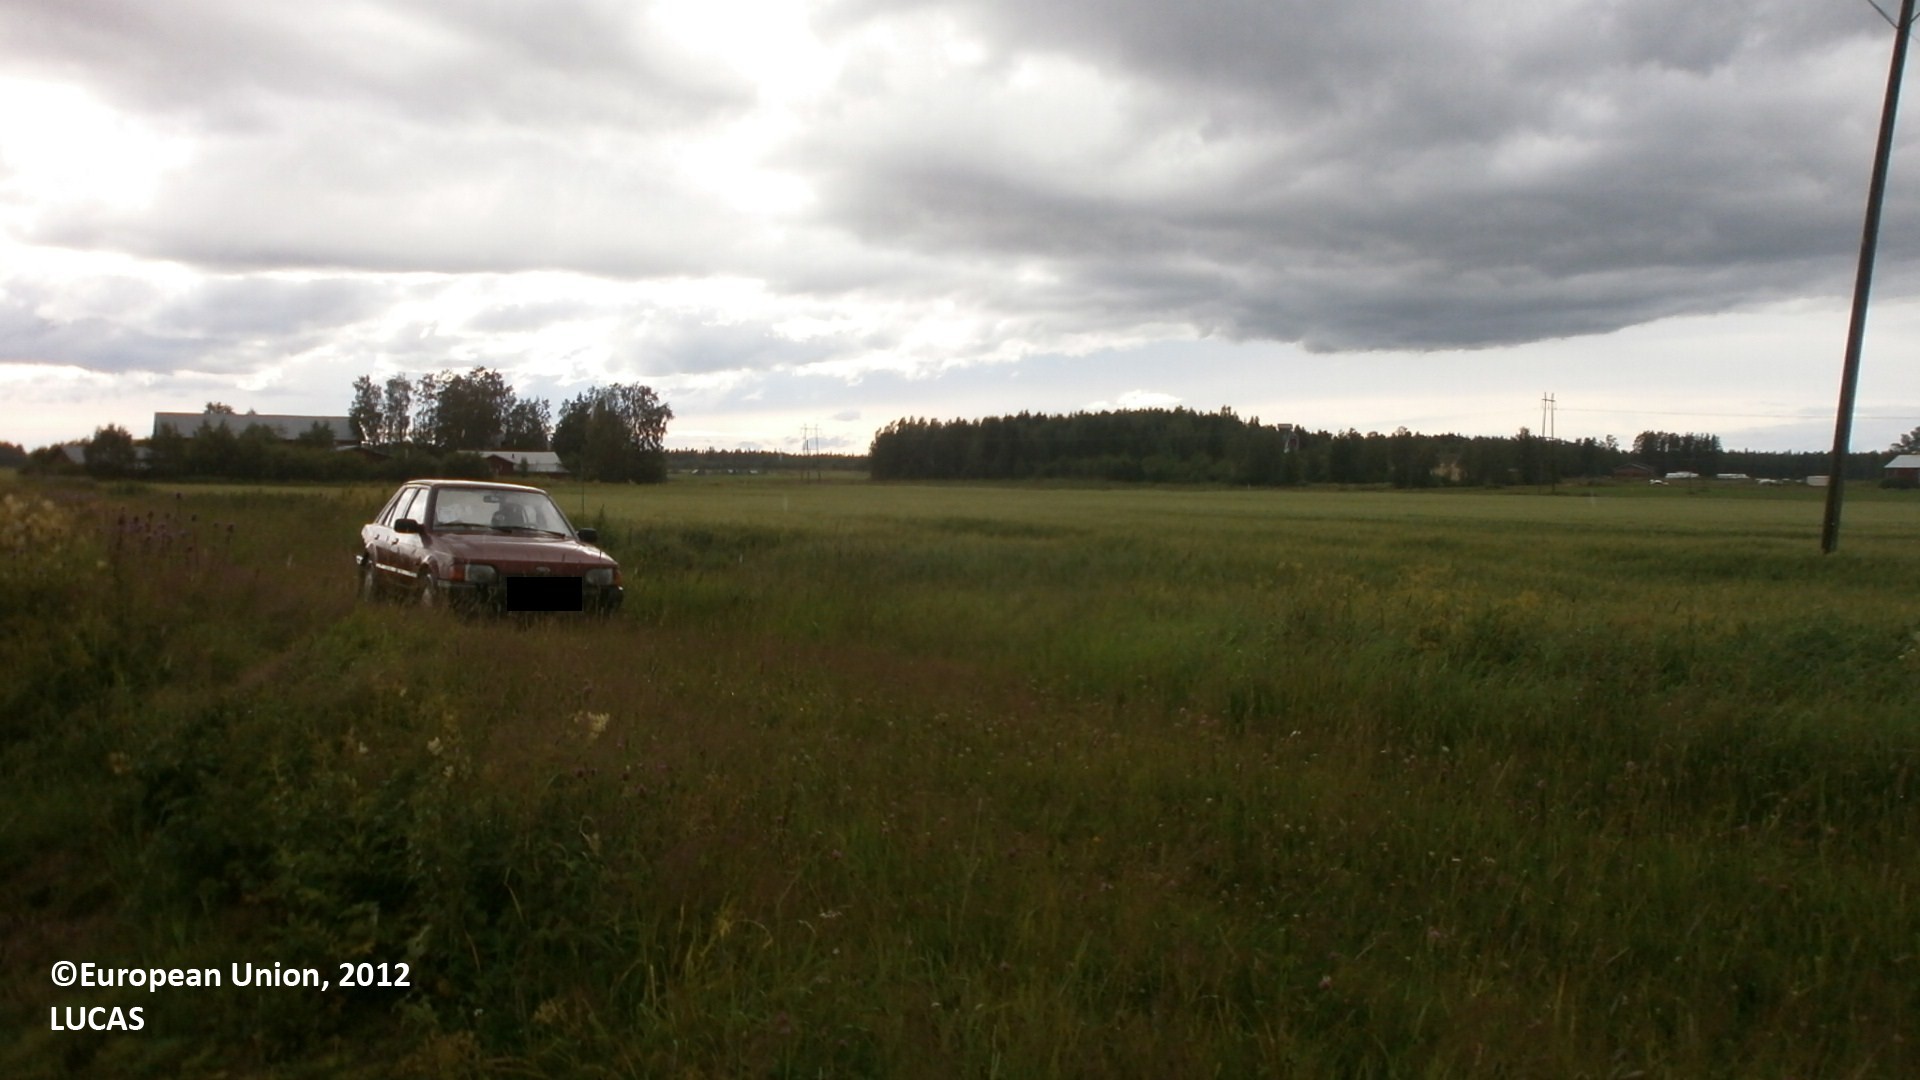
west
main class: Cropland
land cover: Barley
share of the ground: 50 - 75 %
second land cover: Oats
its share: 50 - 75 %
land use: Agriculture (excluding fallow land and kitchen gardens)
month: July
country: FI
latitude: 63.9174
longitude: 24.2387
